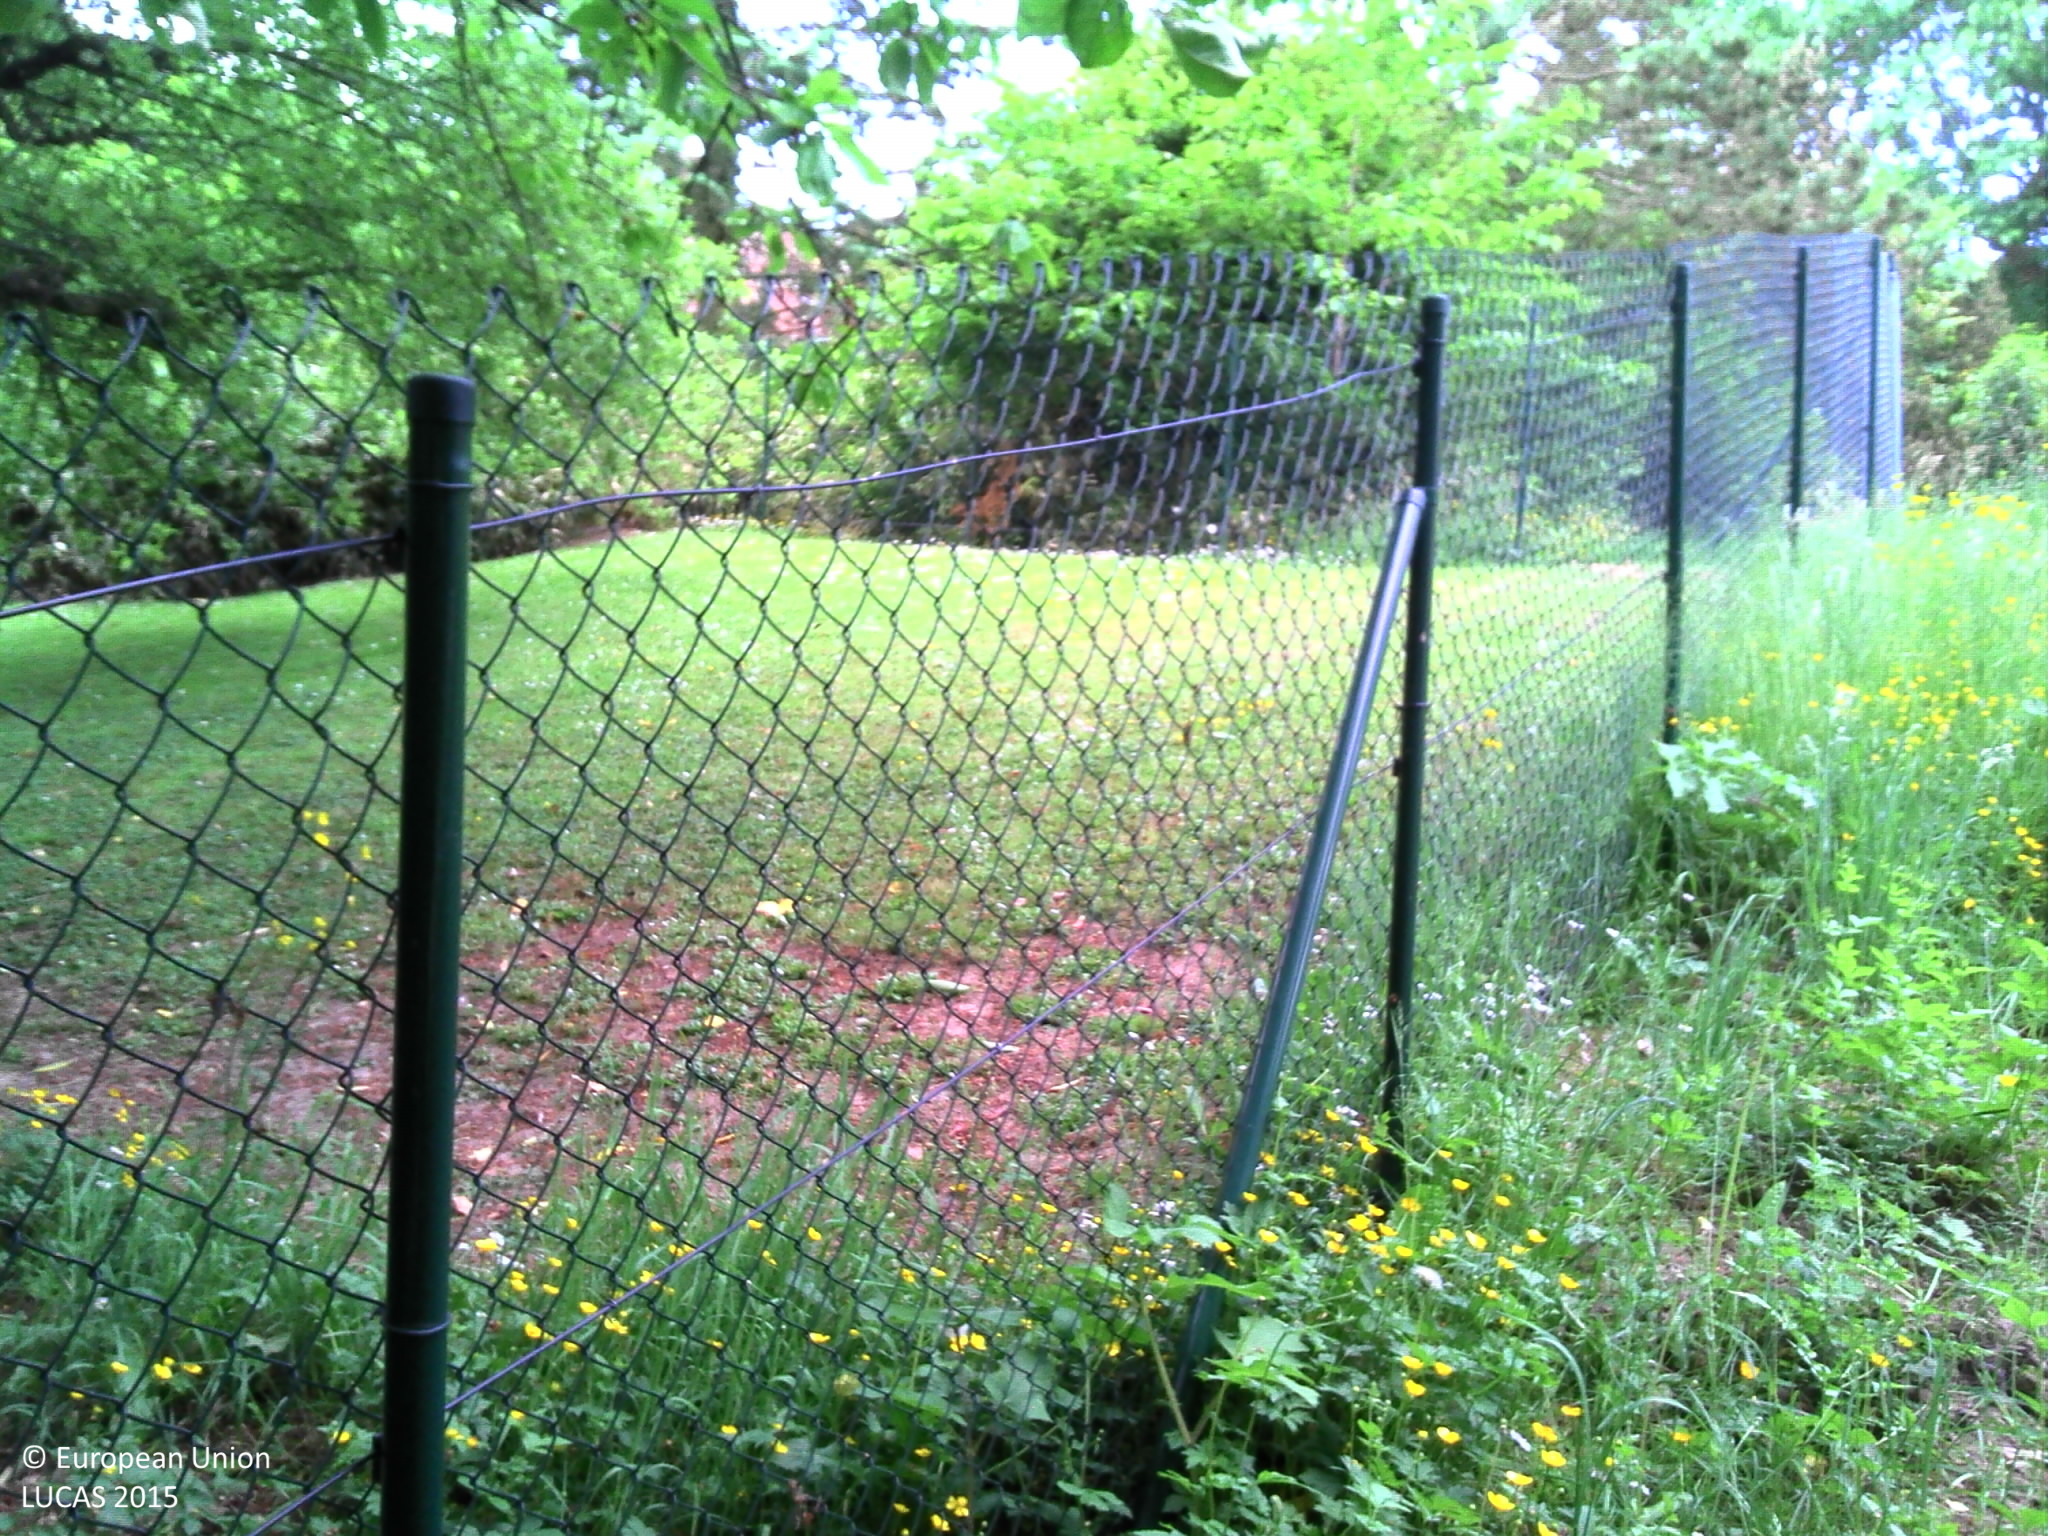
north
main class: Woodland
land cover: Broadleaved woodland
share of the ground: > 75 %
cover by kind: broadleaved forest trees 100 %
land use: Residential
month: May
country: BE
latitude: 50.7270
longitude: 4.6839
